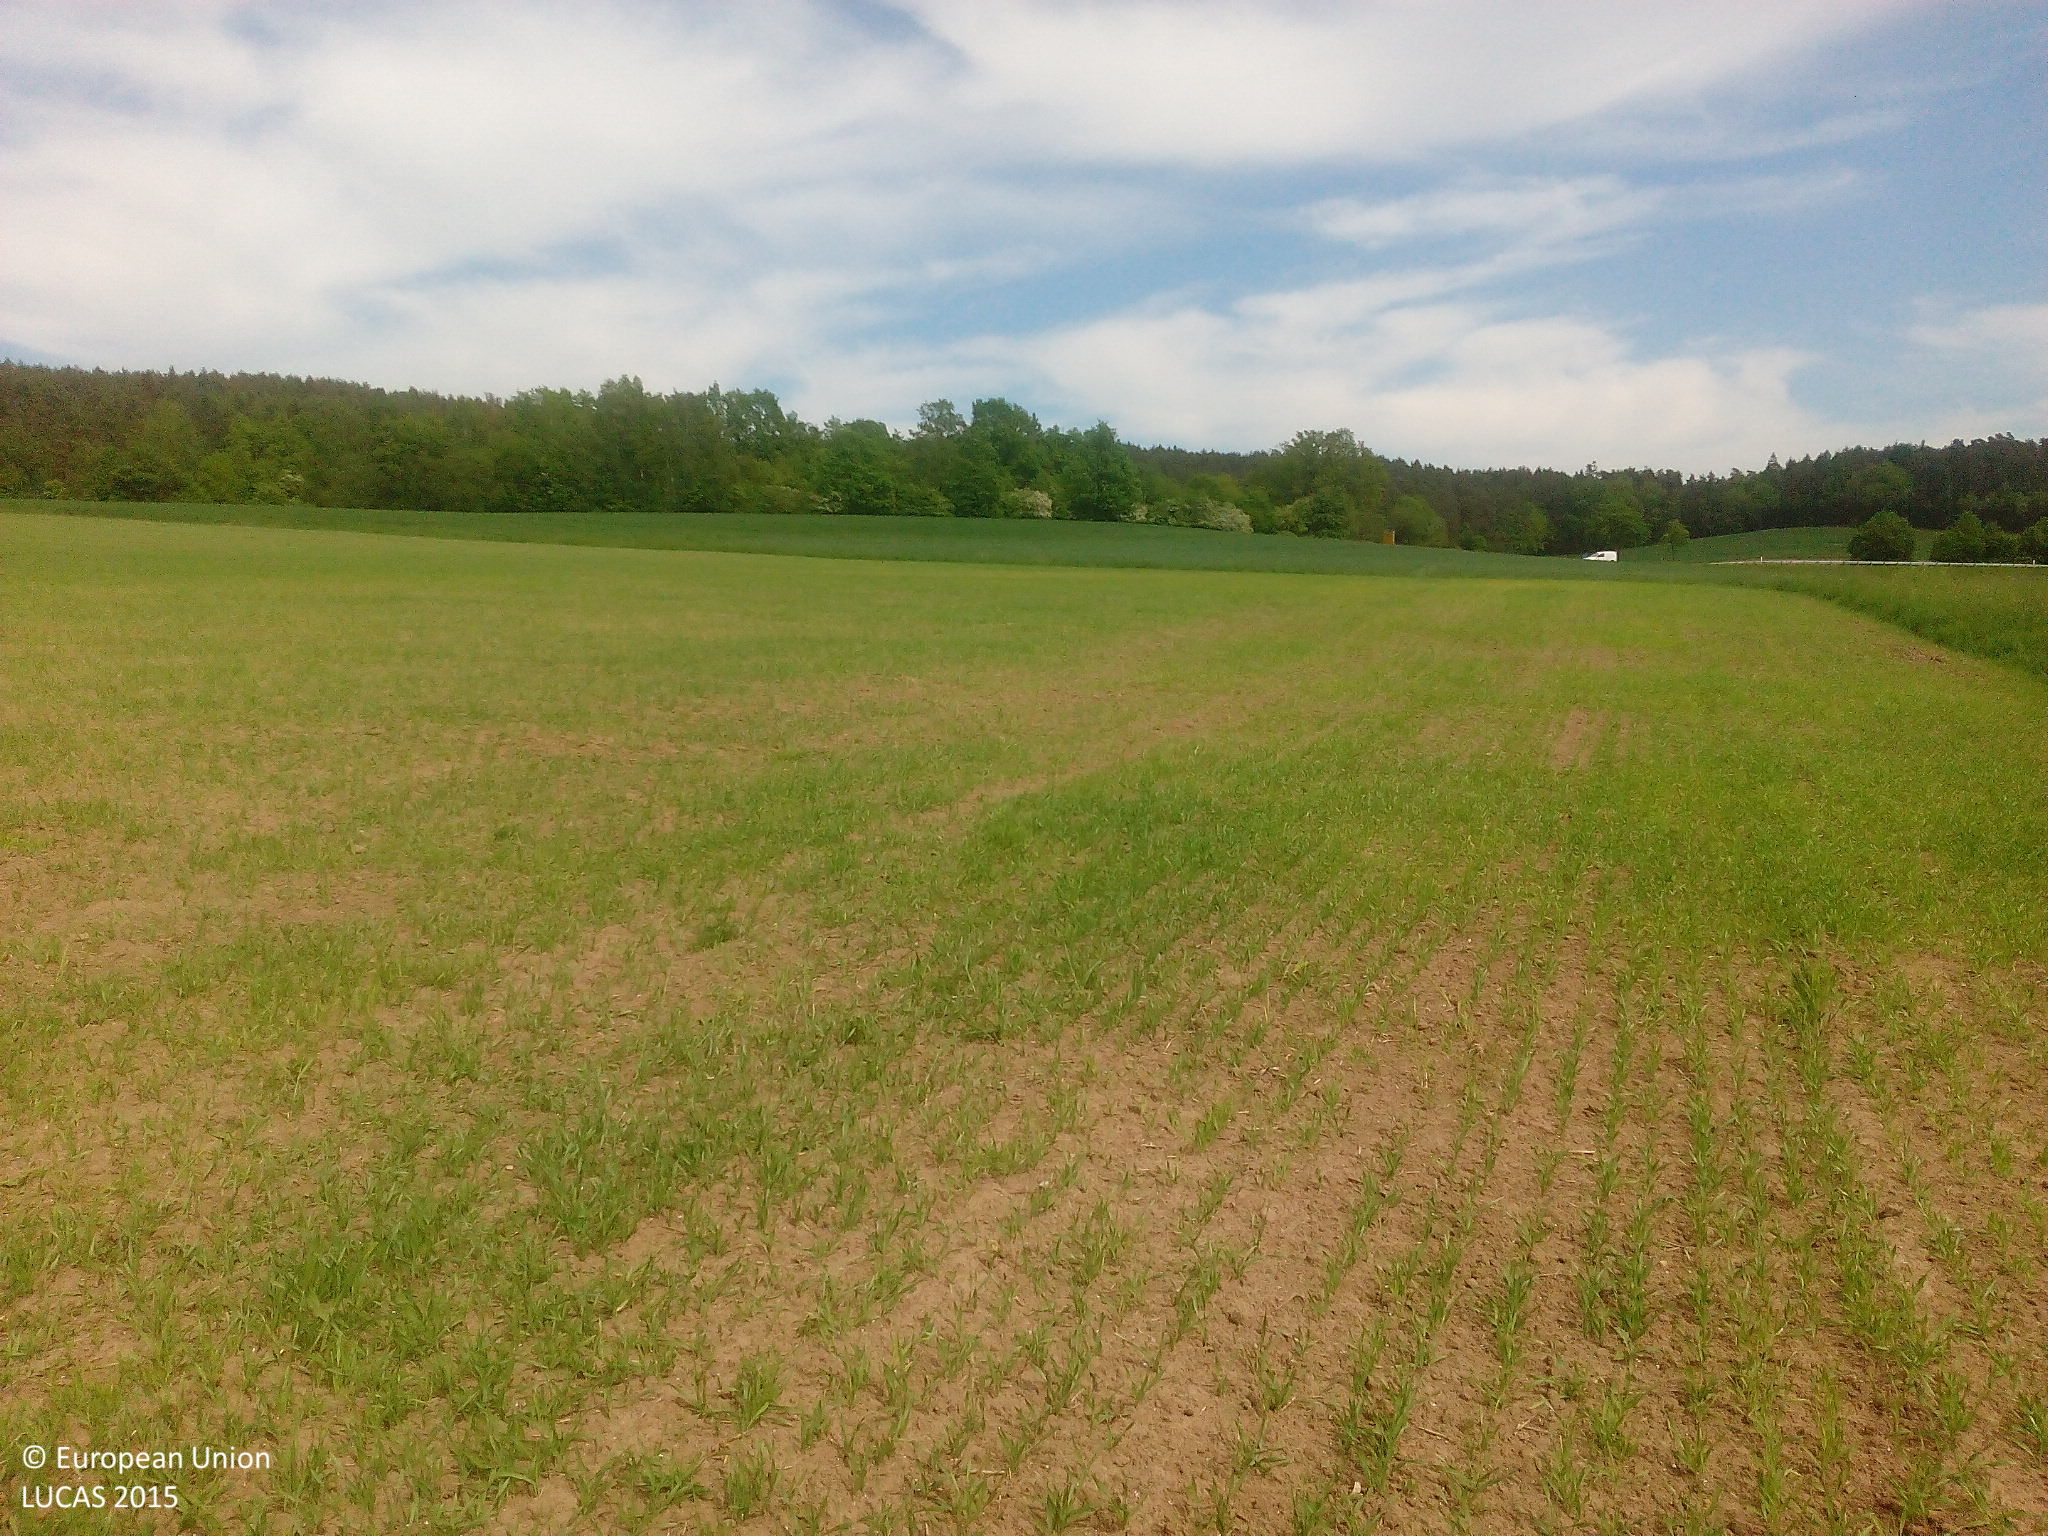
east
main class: Cropland
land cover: Common wheat
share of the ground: 25 - 50 %
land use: Agriculture (excluding fallow land and kitchen gardens)
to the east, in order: Common wheat; Tracks; Common wheat; Grass margins; Triticale; Lines of trees; Ditches and canals; Grass margins; Paved roads, cycling and walking lanes; Grass margins; Ditches and canals; Broadleaved woodland; Paved roads, cycling and walking lanes; Grass margins; Rye
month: May
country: DE
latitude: 50.0306
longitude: 11.4933
